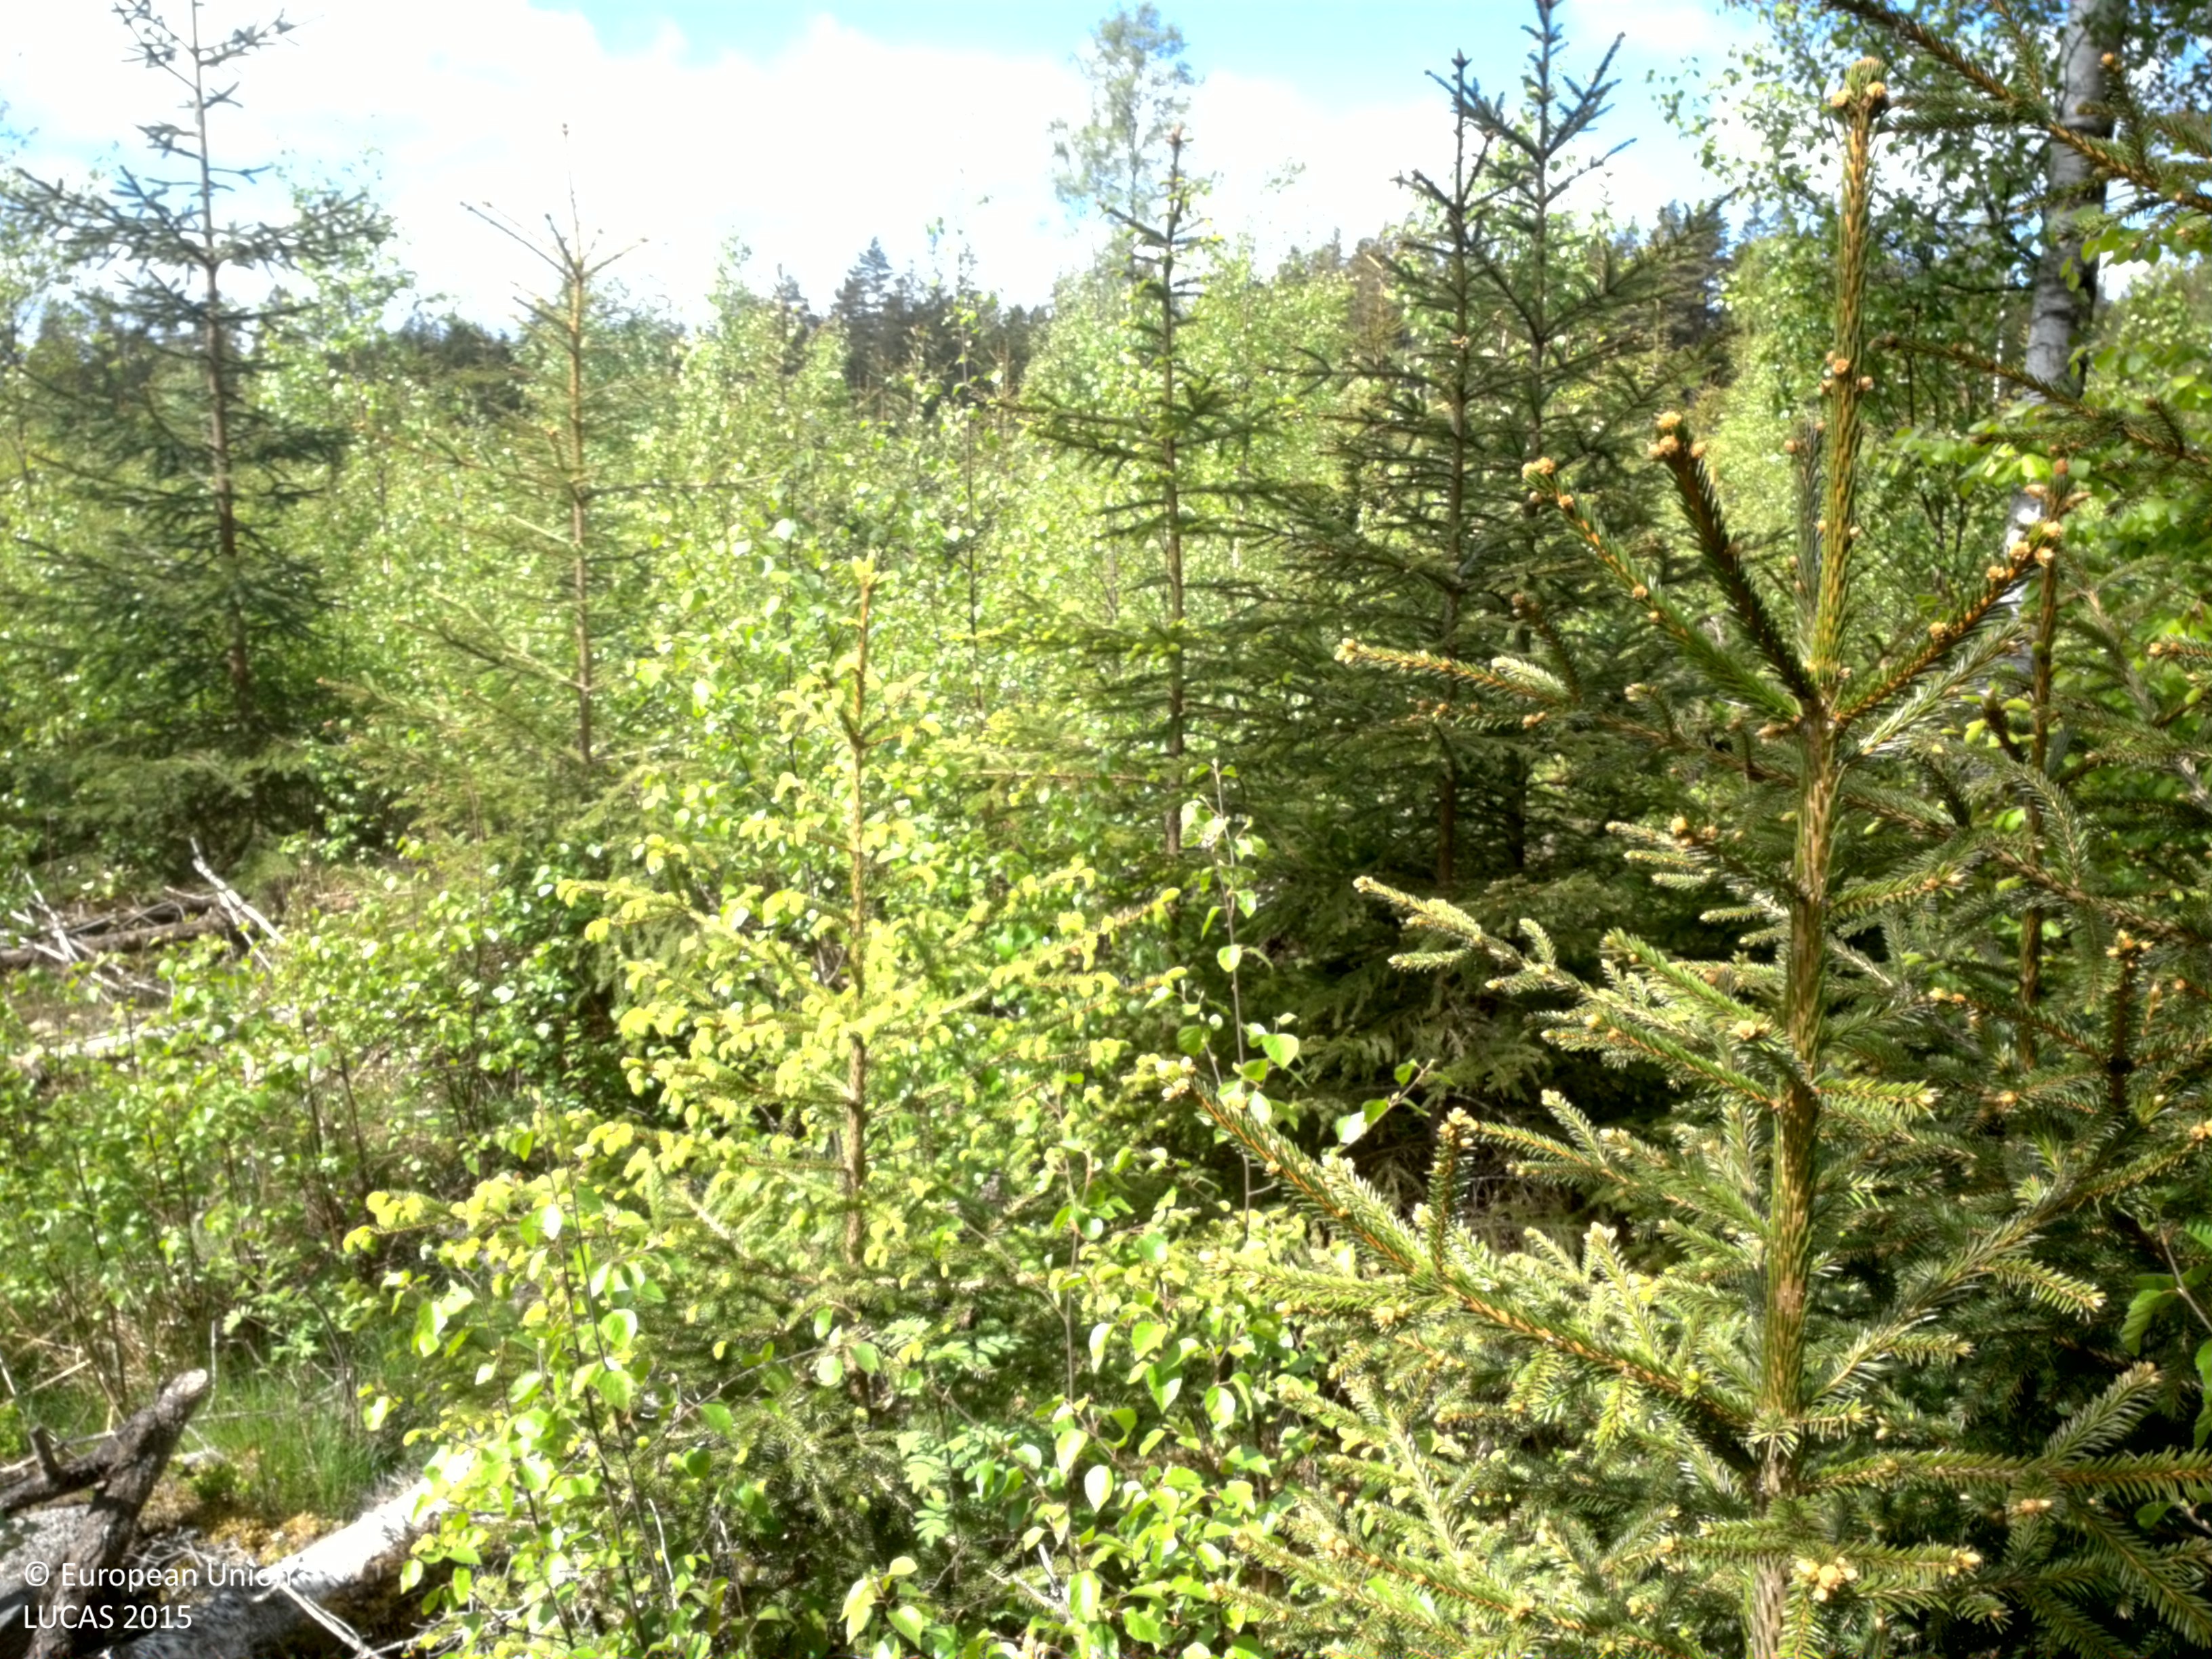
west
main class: Woodland
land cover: Spruce dominated mixed woodland
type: boreal forest
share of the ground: > 75 %
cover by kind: broadleaved forest trees 60 %, coniferous forest trees 20 %, shrubs 20 %
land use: Forestry
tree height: < 5 m
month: May
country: SE
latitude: 56.5002
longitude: 15.1156
